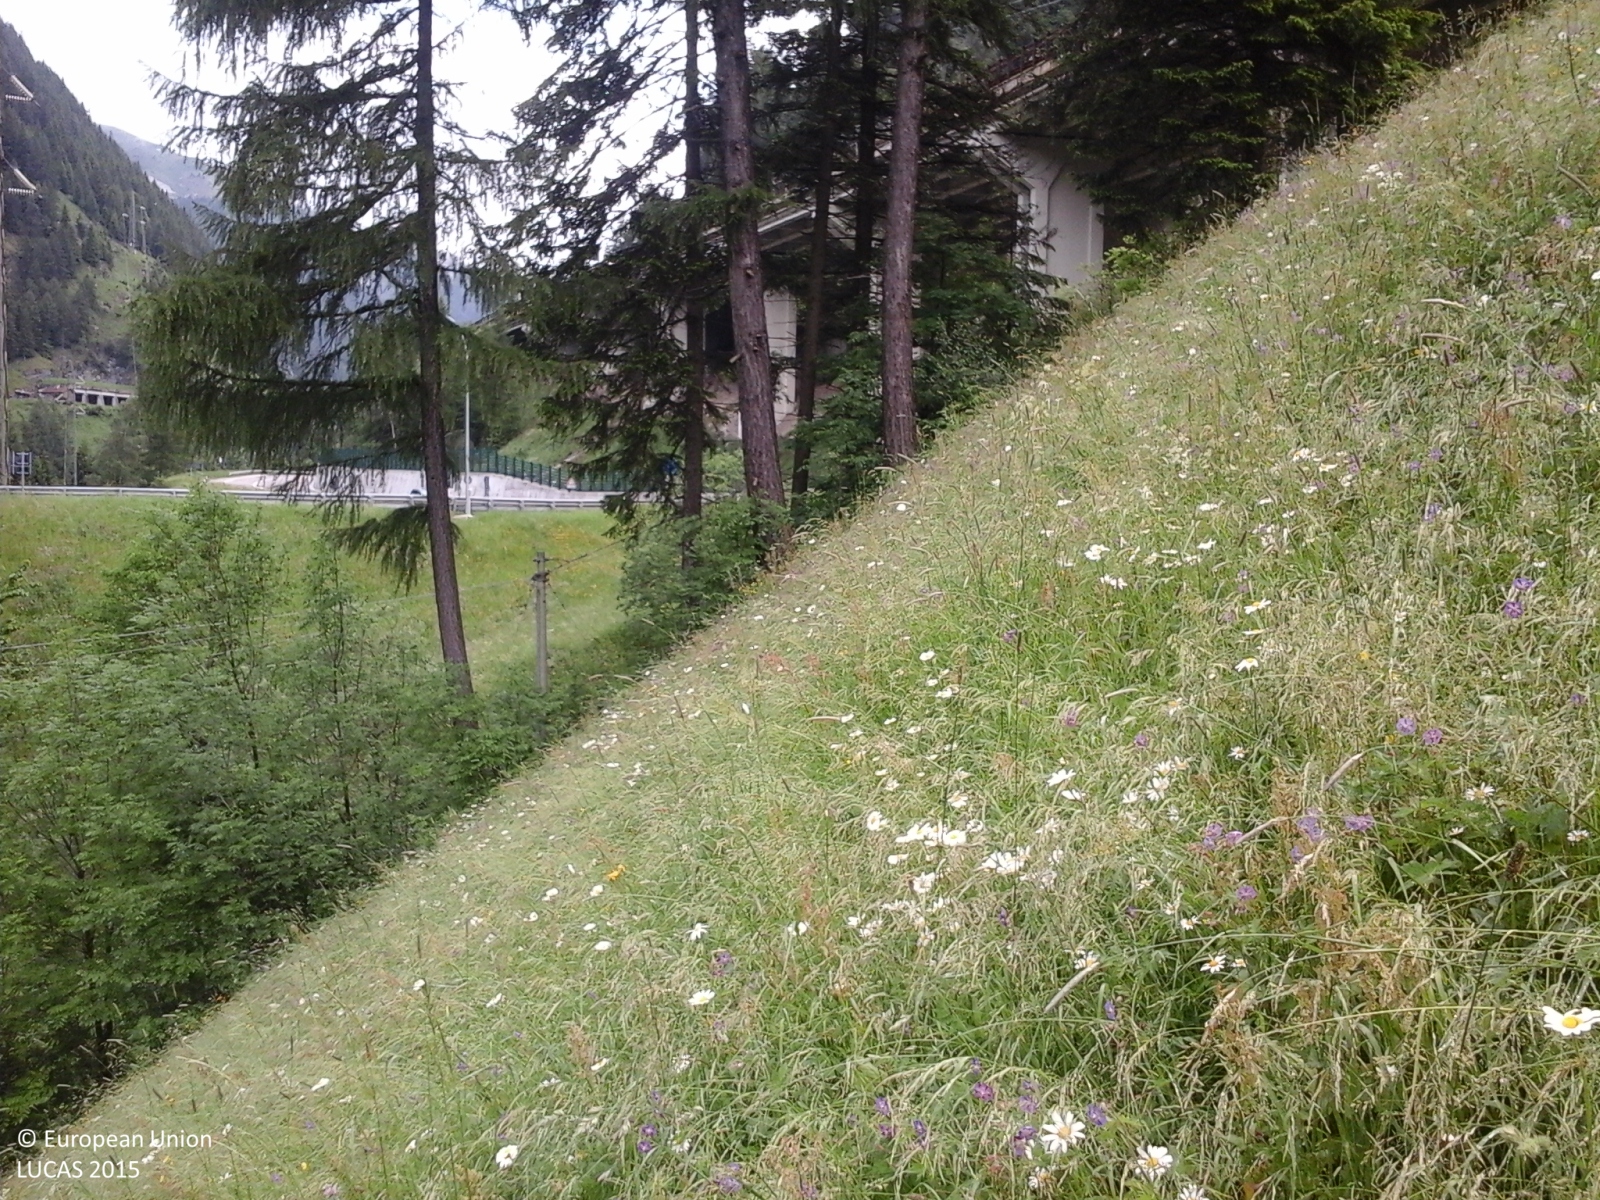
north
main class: Grassland
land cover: Grassland without tree/shrub cover
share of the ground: > 75 %
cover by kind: herbaceous plants 100 %
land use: Agriculture (excluding fallow land and kitchen gardens)
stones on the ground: < 10 %
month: June
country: IT
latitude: 46.9537
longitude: 11.4570
